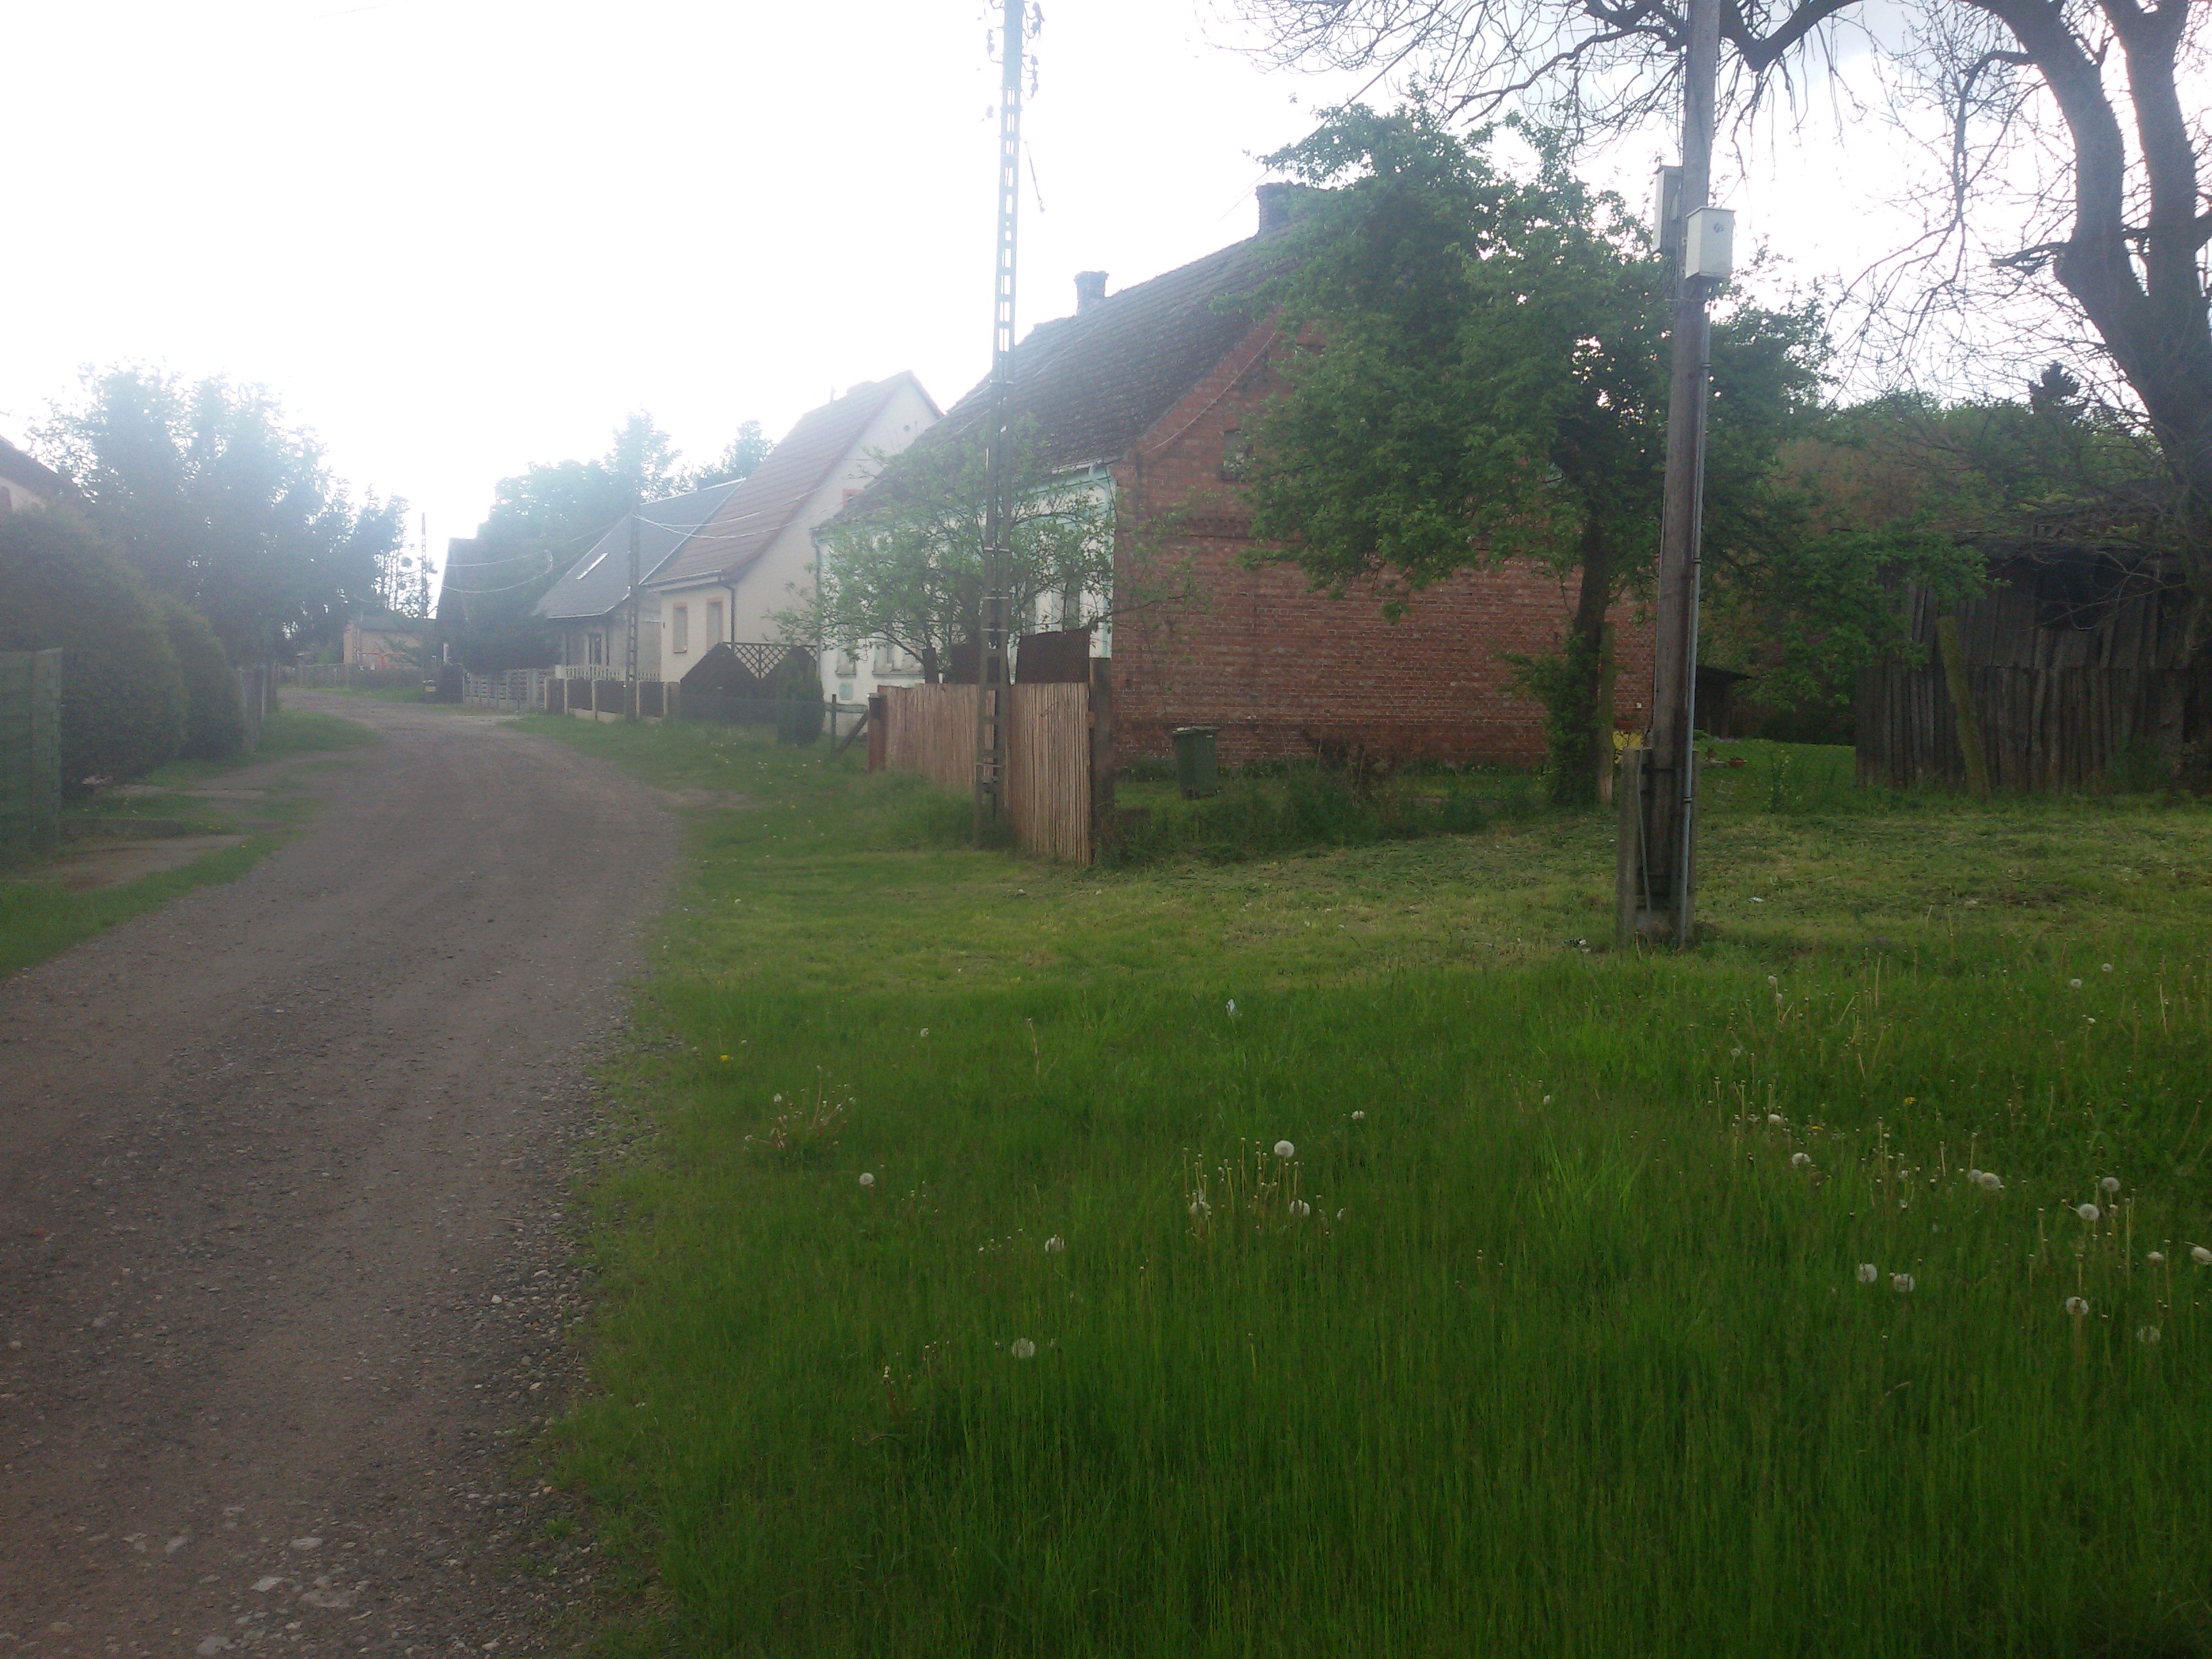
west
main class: Grassland
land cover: Grassland with sparse tree/shrub cover
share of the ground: 50 - 75 %
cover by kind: herbaceous plants 85 %, shrubs 10 %, broadleaved forest trees 5 %
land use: Residential
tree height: < 5 m
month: May
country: PL
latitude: 53.5698
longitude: 14.5160
